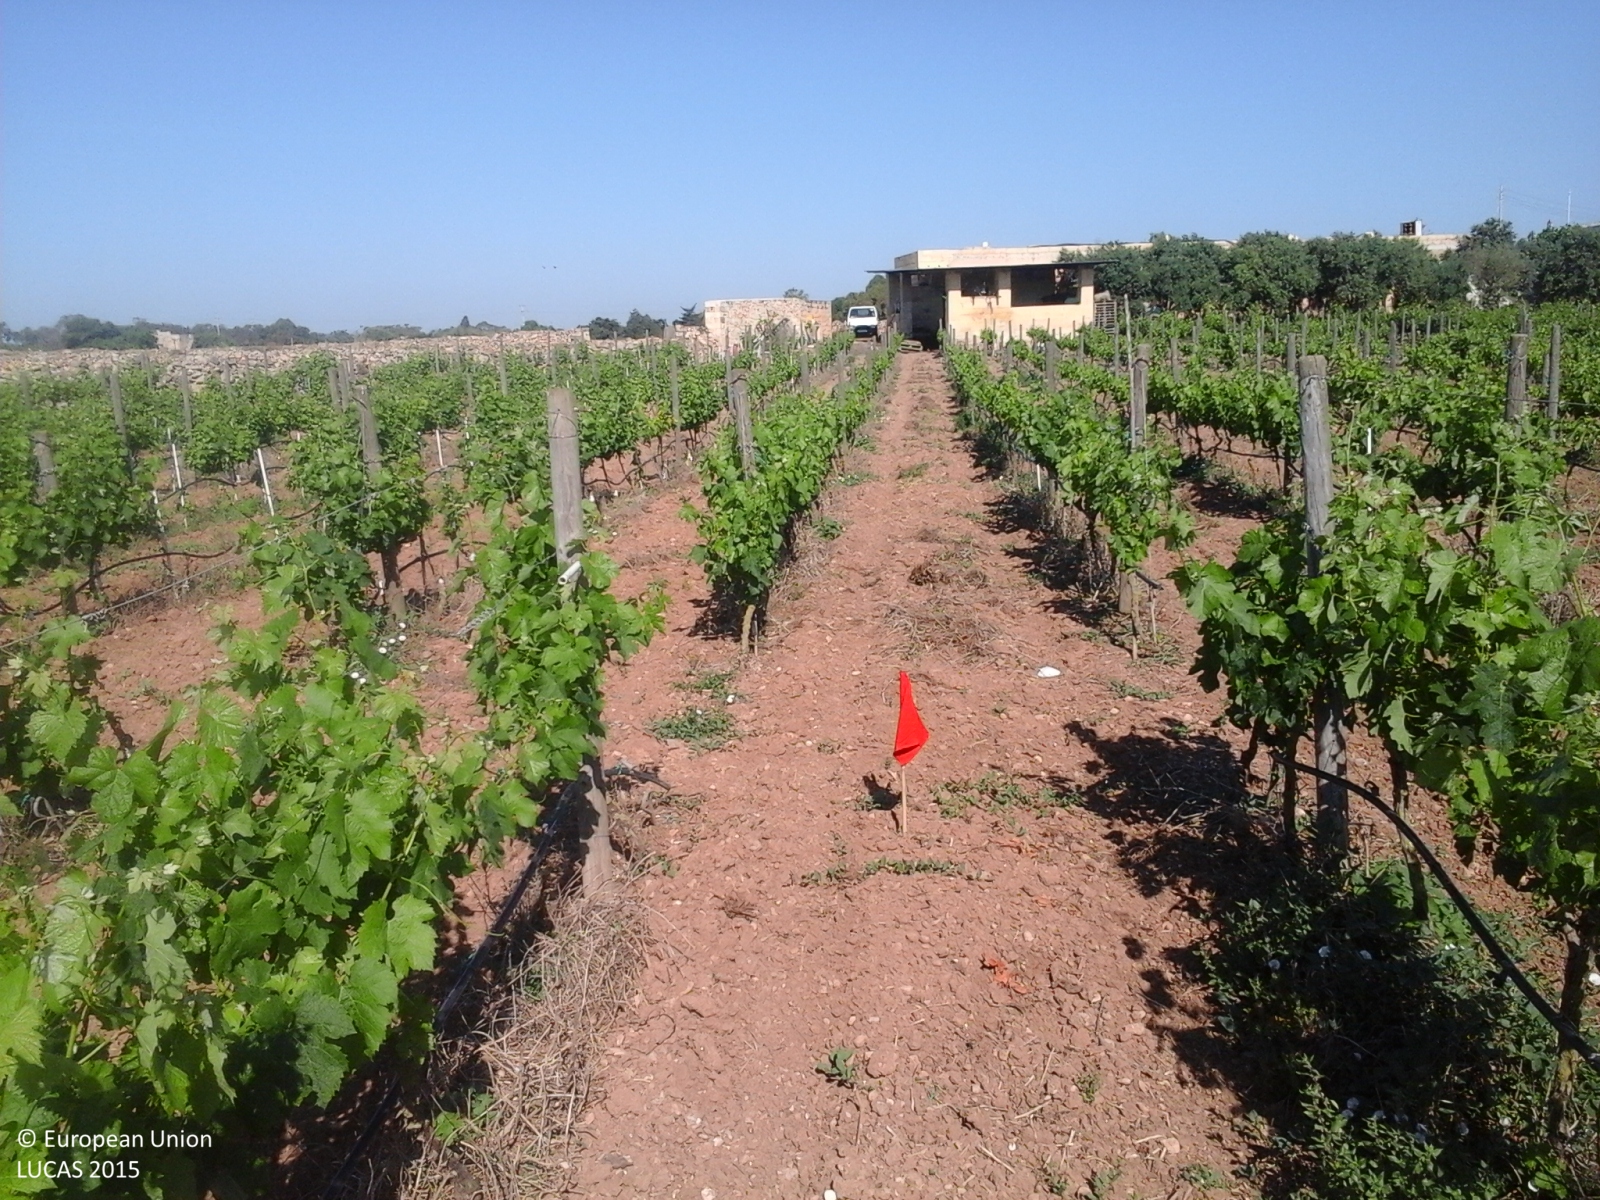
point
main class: Cropland
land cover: Vineyards
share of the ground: 25 - 50 %
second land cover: Other bare soil
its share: > 75 %
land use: Agriculture (excluding fallow land and kitchen gardens)
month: May
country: MT
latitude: 35.8571
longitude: 14.5094
